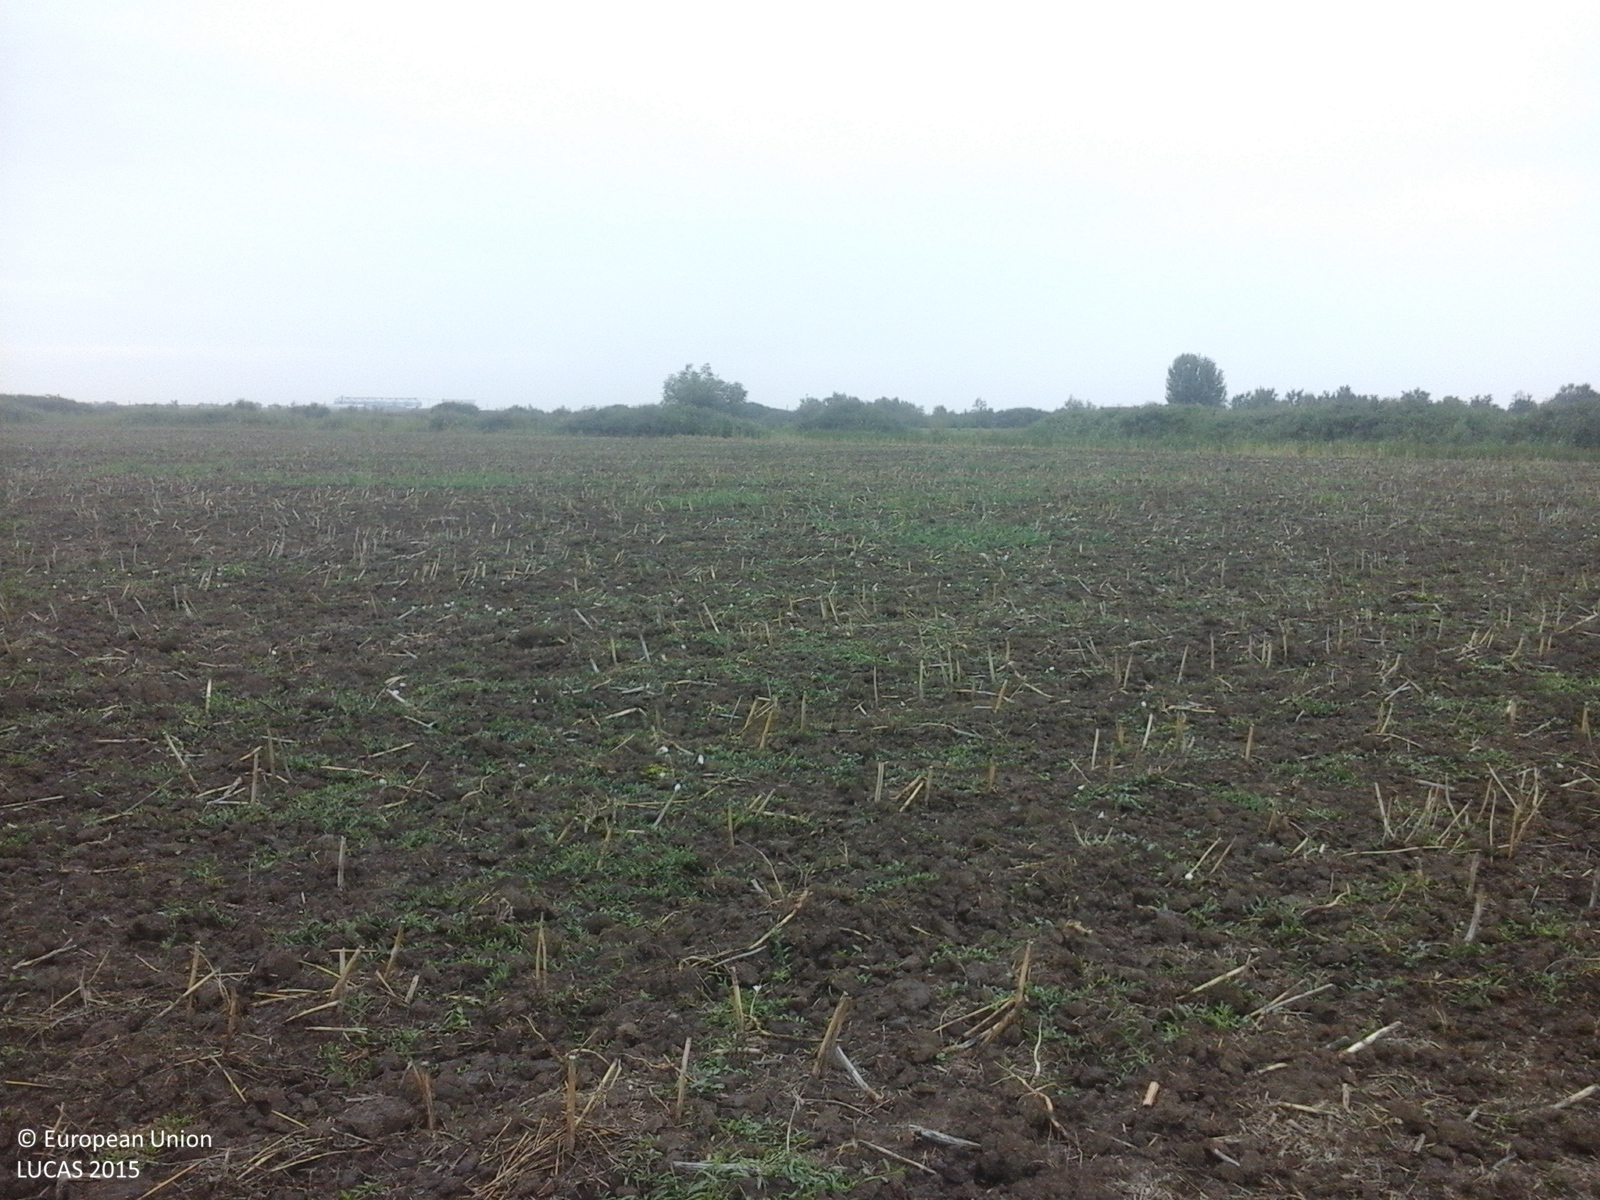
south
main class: Cropland
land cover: Rape and turnip rape
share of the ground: < 10 %
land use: Agriculture (excluding fallow land and kitchen gardens)
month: August
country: RO
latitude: 45.4209
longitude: 20.9782
